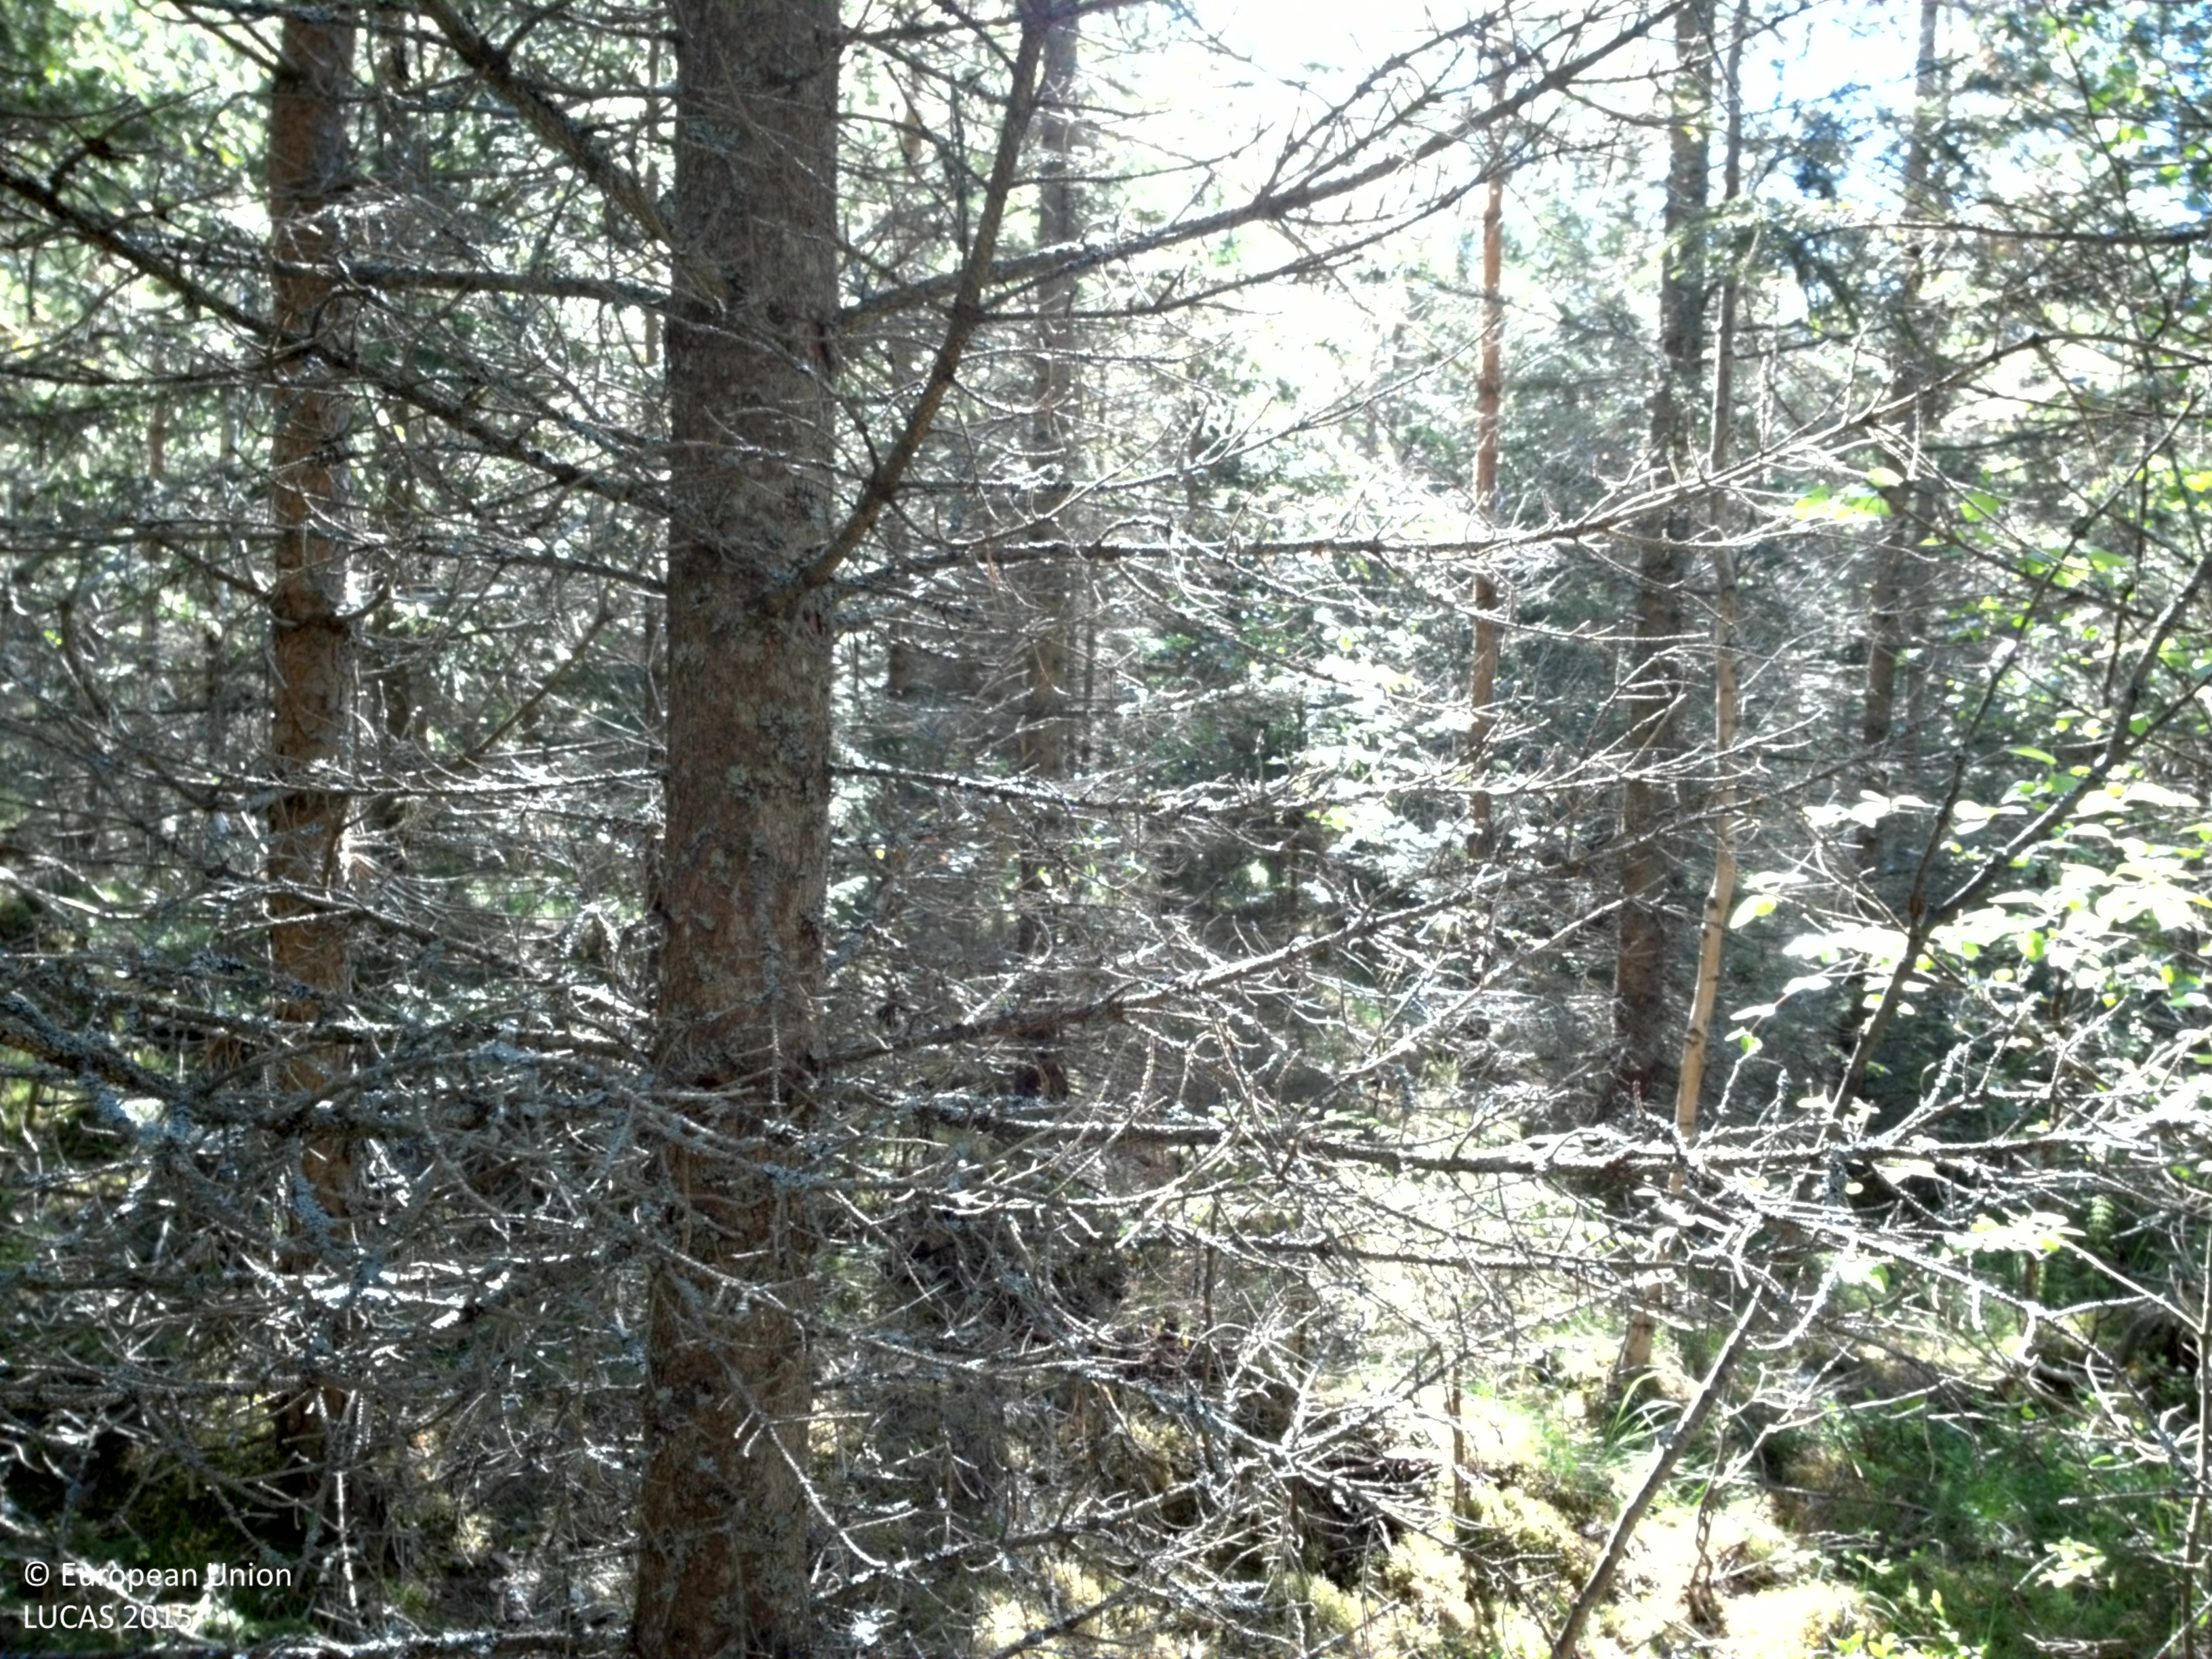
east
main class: Woodland
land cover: Spruce dominated mixed woodland
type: boreal forest
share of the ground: > 75 %
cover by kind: coniferous forest trees 70 %, broadleaved forest trees 25 %, lichens and mosses 5 %
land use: Forestry
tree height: > 5 m
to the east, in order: Spruce dominated mixed woodland; Ditches and canals; Spruce dominated mixed woodland; Pine dominated coniferous woodland; Rocks and stones; Pine dominated mixed woodland; Spruce dominated mixed woodland; Tracks; Spruce dominated mixed woodland; Spruce dominated coniferous woodland
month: June
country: SE
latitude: 58.7018
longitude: 14.5320
